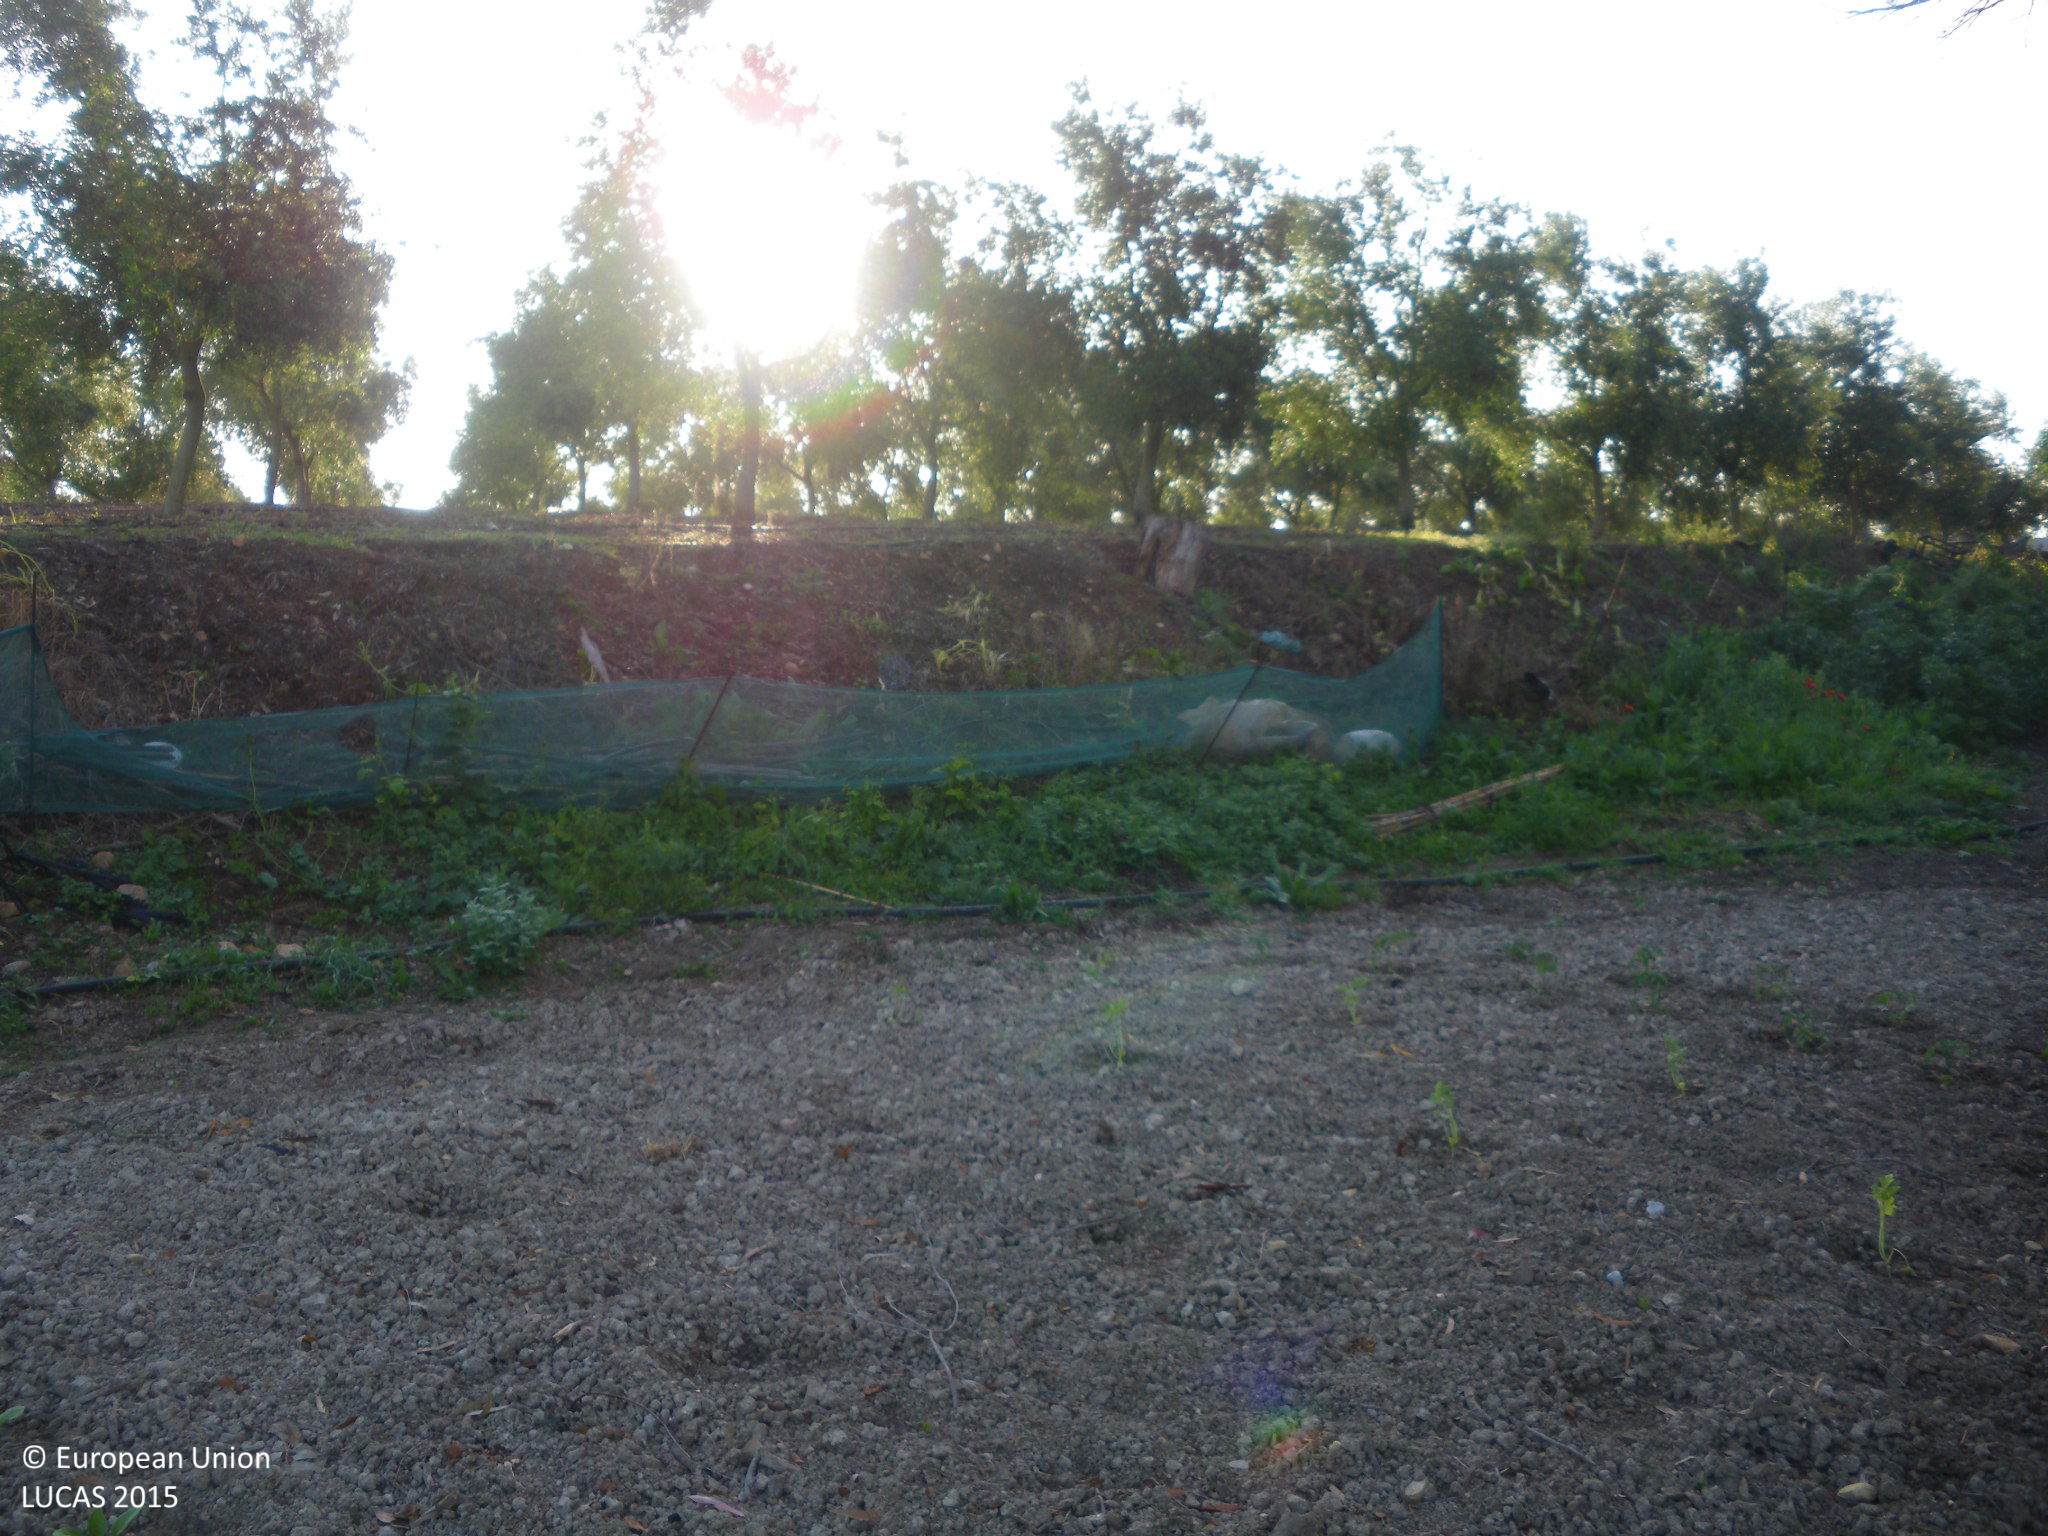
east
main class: Woodland
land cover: Broadleaved woodland
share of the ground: 25 - 50 %
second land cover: Other fresh vegetables
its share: < 10 %
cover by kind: unconsolidated bare surface 70 %, broadleaved forest trees 25 %, herbaceous plants 5 %
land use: Forestry
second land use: Agriculture (excluding fallow land and kitchen gardens)
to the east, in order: Broadleaved woodland; Other fresh vegetables; Grass margins; Olive groves; Other fresh vegetables; Olive groves; Tracks; Olive groves
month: April
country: ES
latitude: 36.6148
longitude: -5.9405
